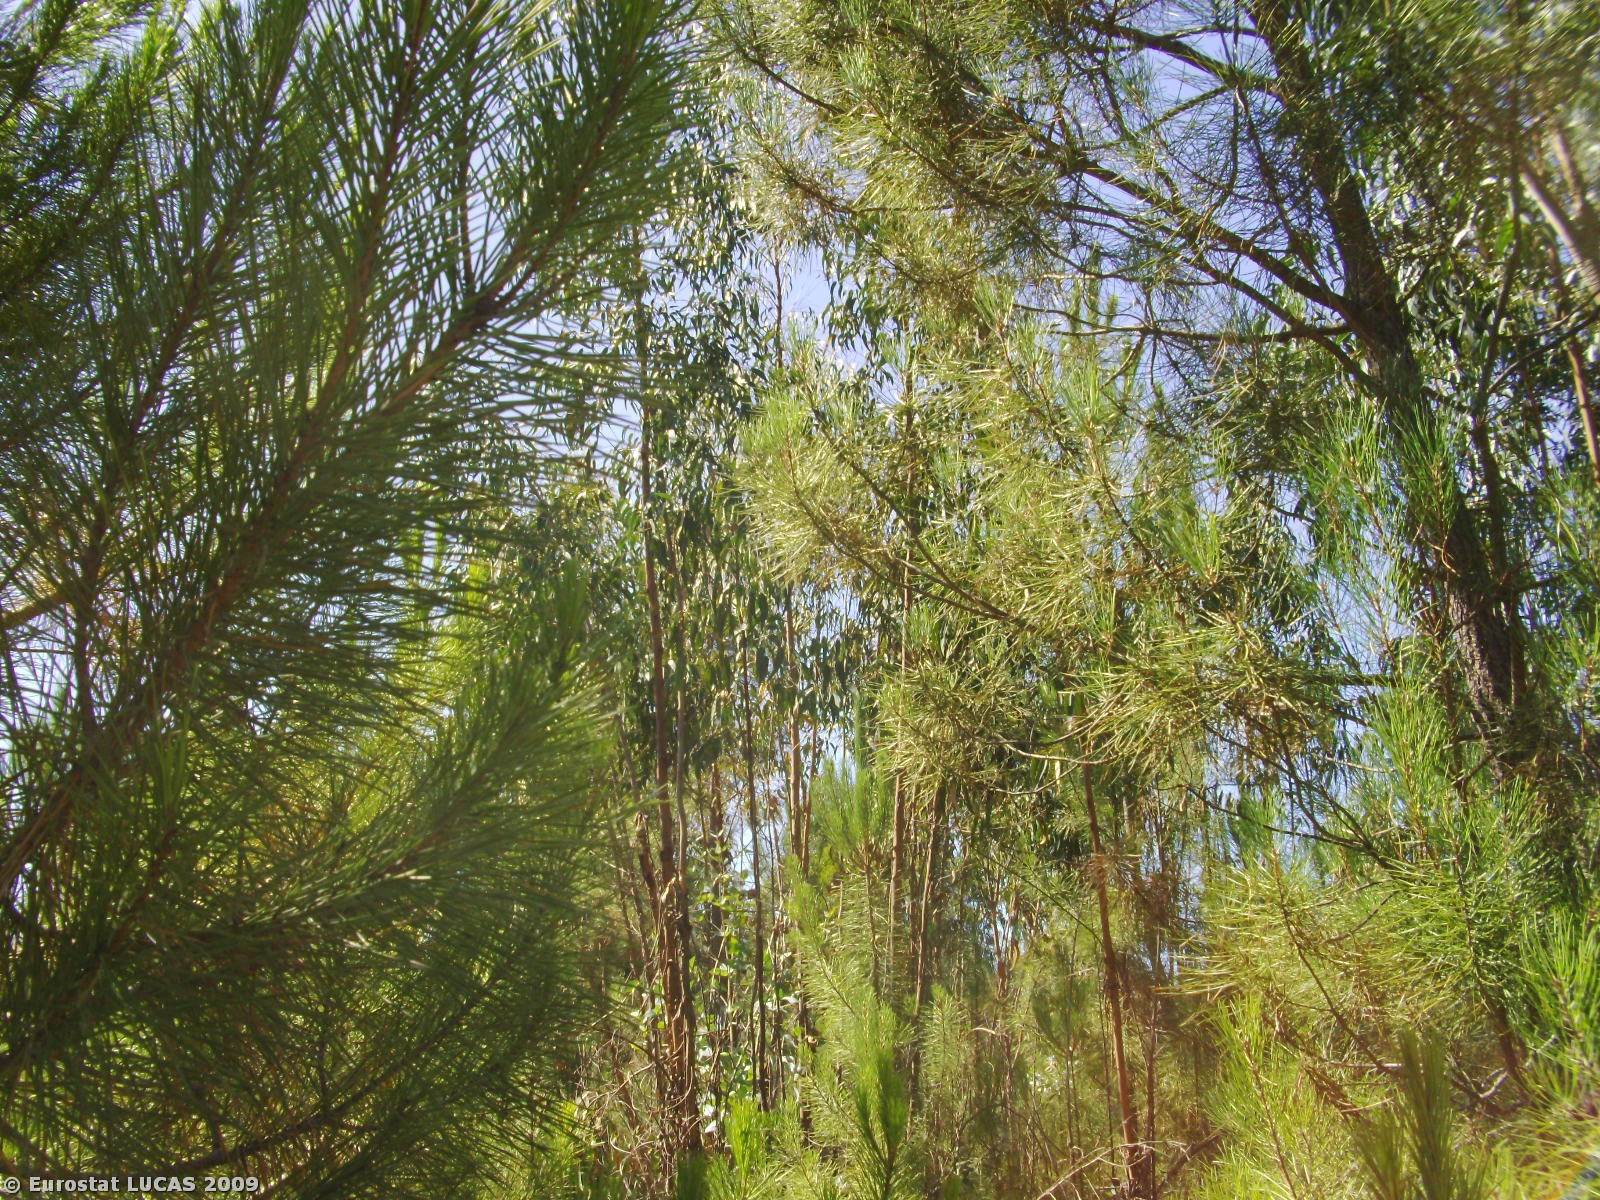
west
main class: Woodland
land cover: Mixed woodland
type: coniferous forest of the mediterranean region
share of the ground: 50 - 75 %
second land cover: Bare land
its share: 25 - 50 %
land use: Forestry
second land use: Fallow land
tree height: > 5 m
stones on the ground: < 10 %
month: August
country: PT
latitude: 38.7271
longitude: -8.7090
